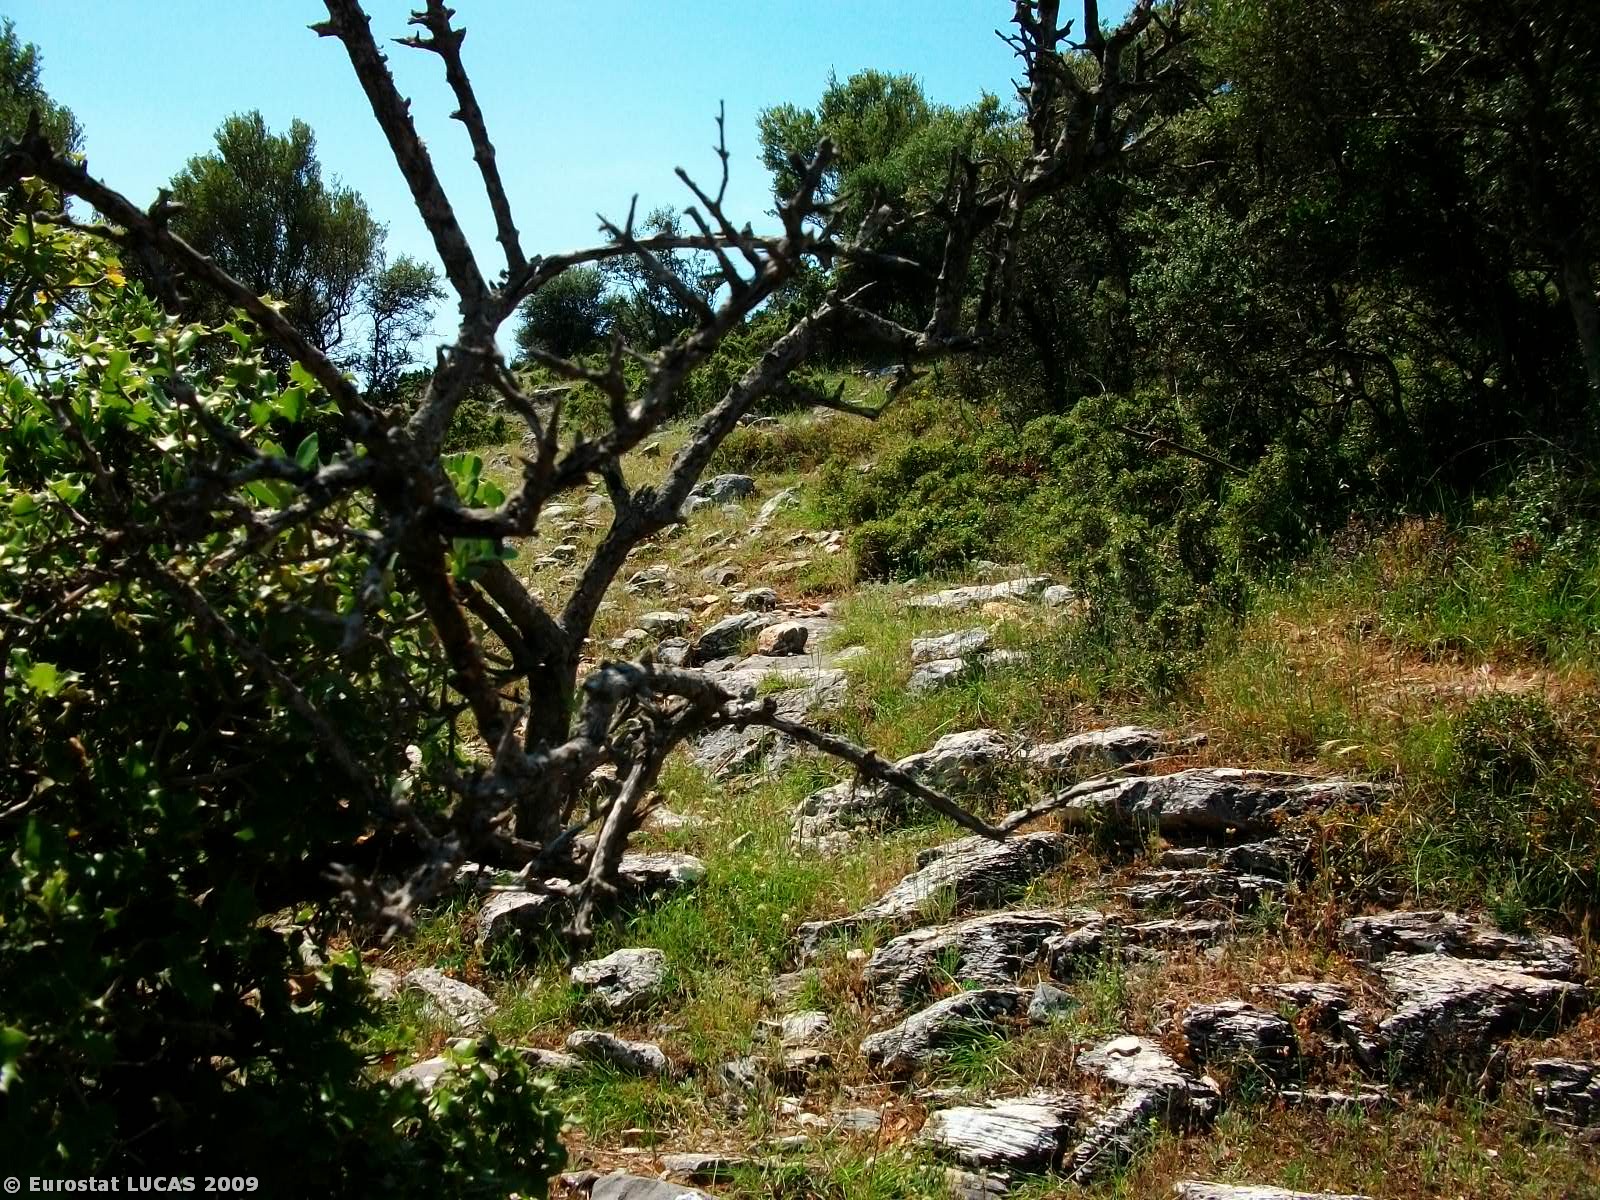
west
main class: Shrubland
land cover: Shrubland with sparse tree cover
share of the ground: 50 - 75 %
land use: Agriculture (excluding fallow land and kitchen gardens)
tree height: < 5 m
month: May
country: GR
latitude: 41.0343
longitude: 24.3886
